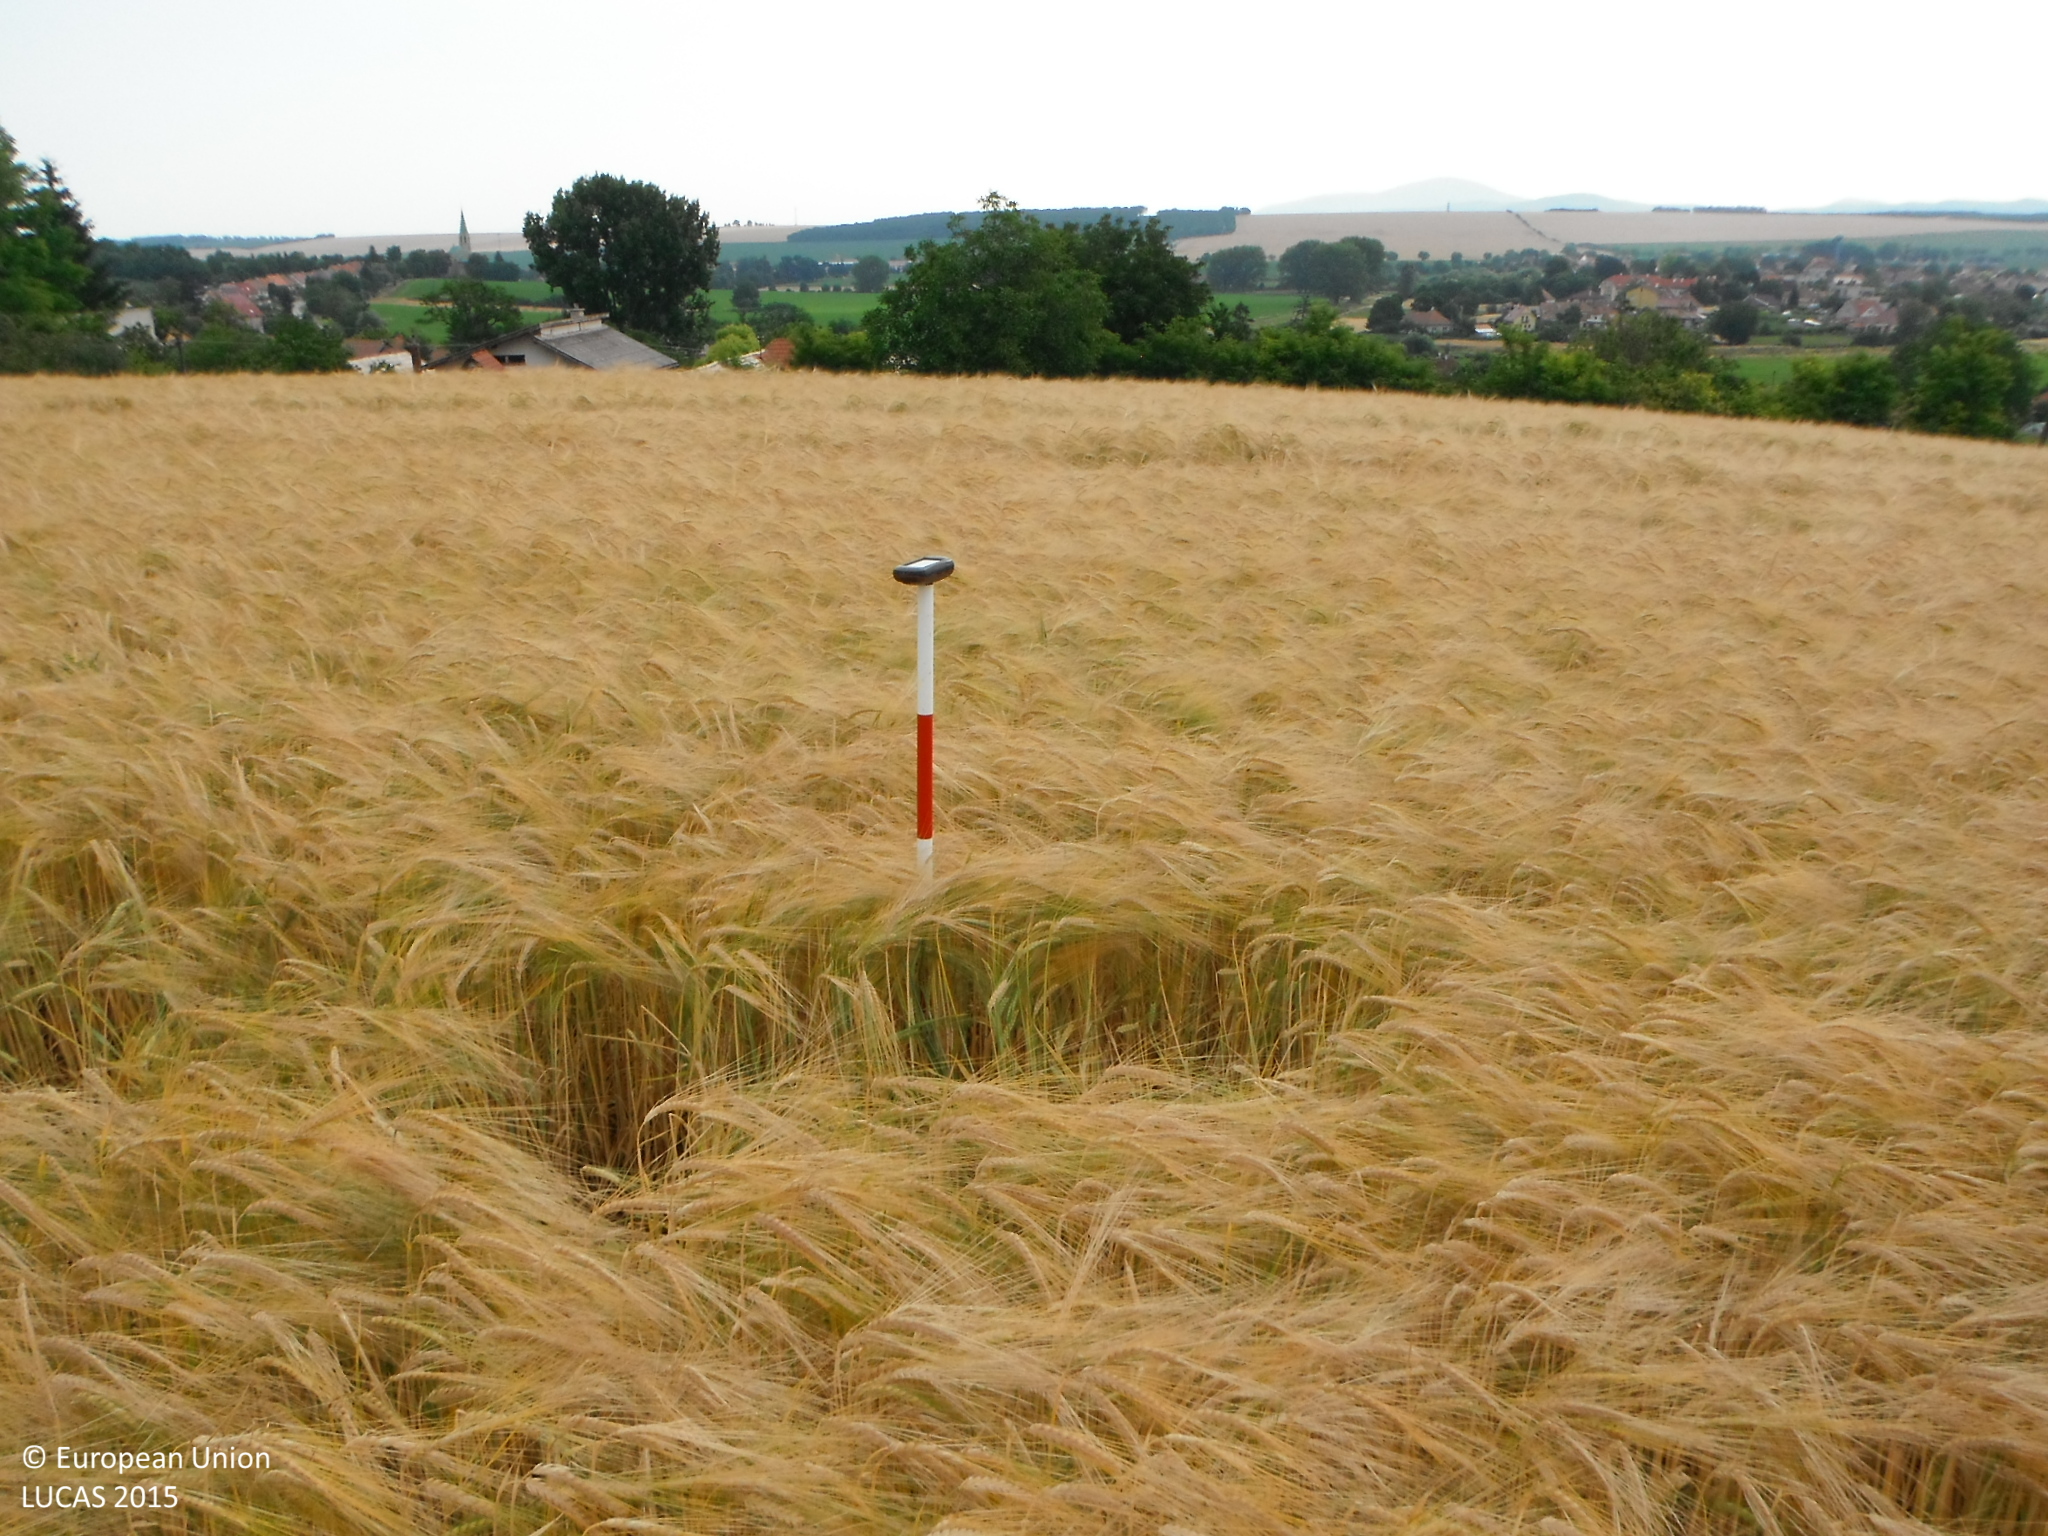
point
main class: Cropland
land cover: Barley
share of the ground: > 75 %
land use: Agriculture (excluding fallow land and kitchen gardens)
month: July
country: SK
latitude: 48.4048
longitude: 17.9696
